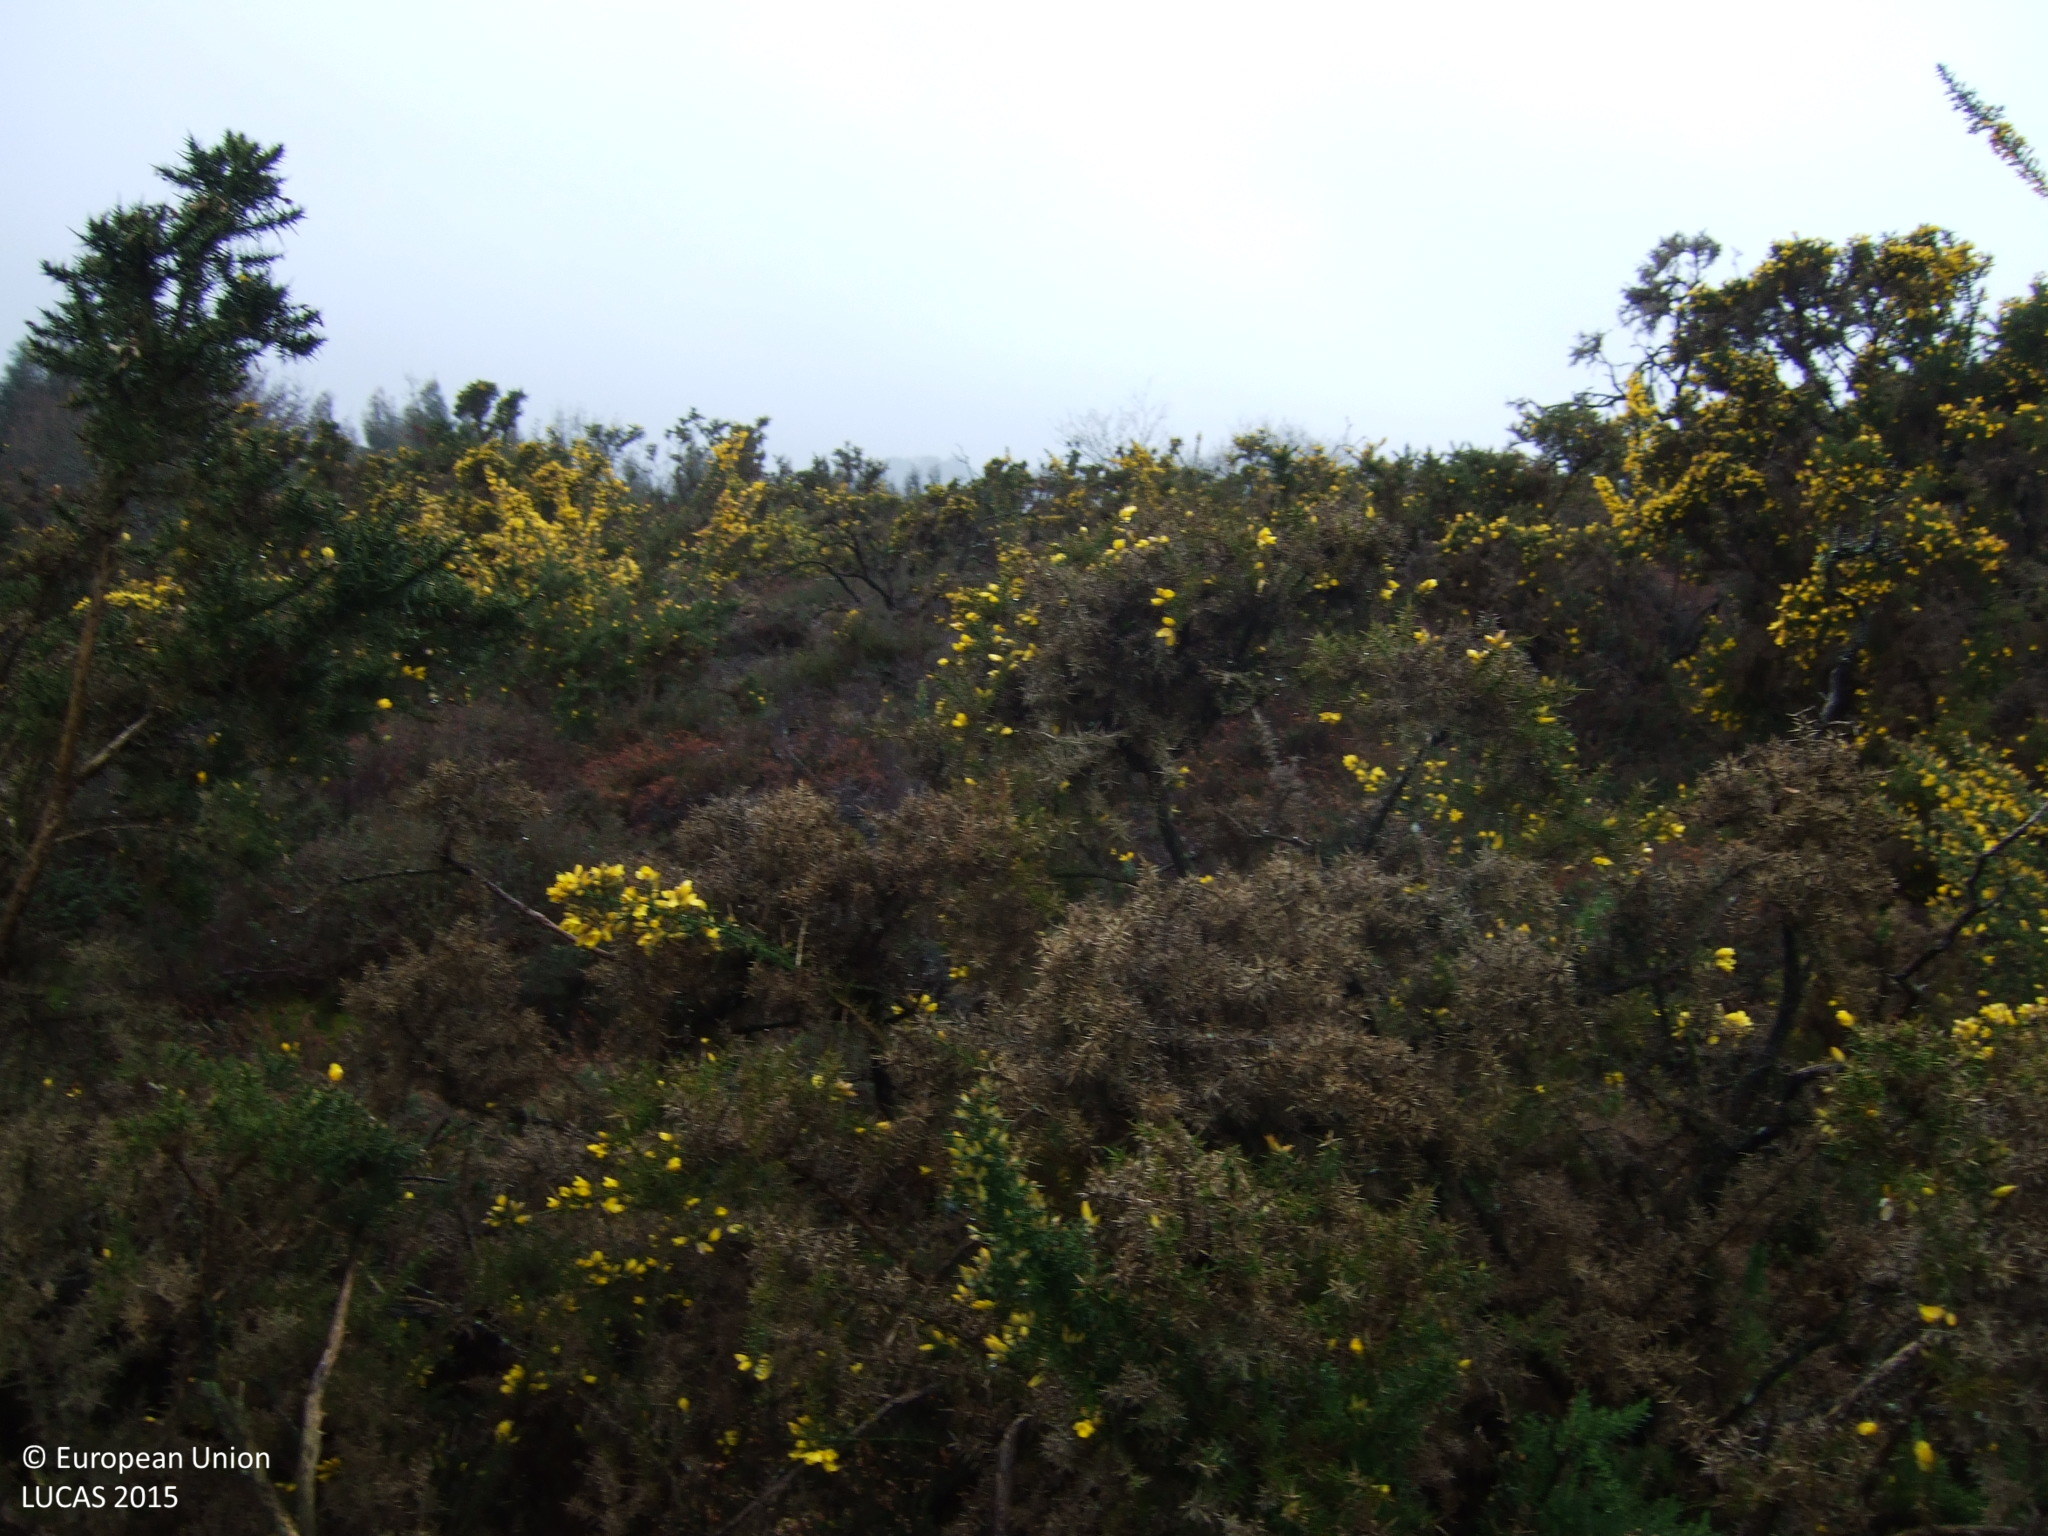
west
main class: Shrubland
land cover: Shrubland without tree cover
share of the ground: > 75 %
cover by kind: shrubs 100 %
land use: Semi-natural and natural areas not in use
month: March
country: ES
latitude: 42.8624
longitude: -7.8429
